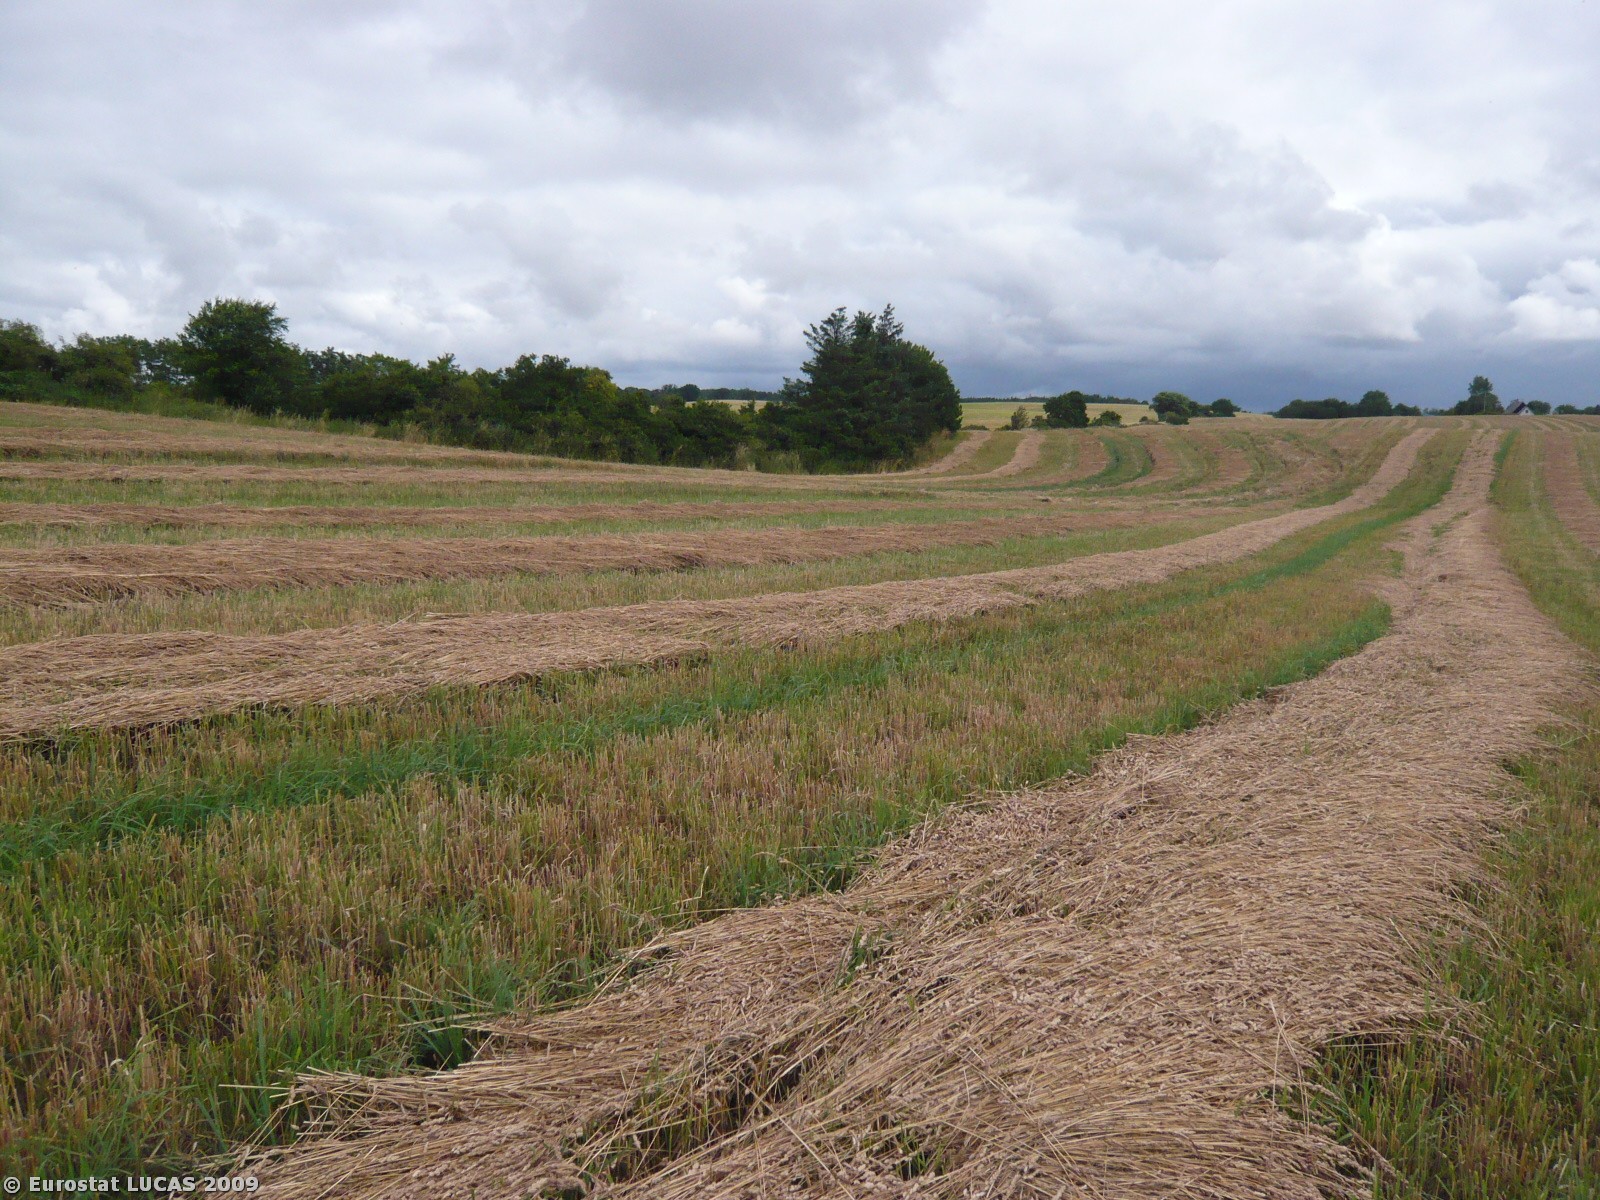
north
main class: Grassland
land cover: Grassland without tree/shrub cover
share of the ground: > 75 %
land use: Agriculture (excluding fallow land and kitchen gardens)
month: July
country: DK
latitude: 55.6240
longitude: 11.2851
